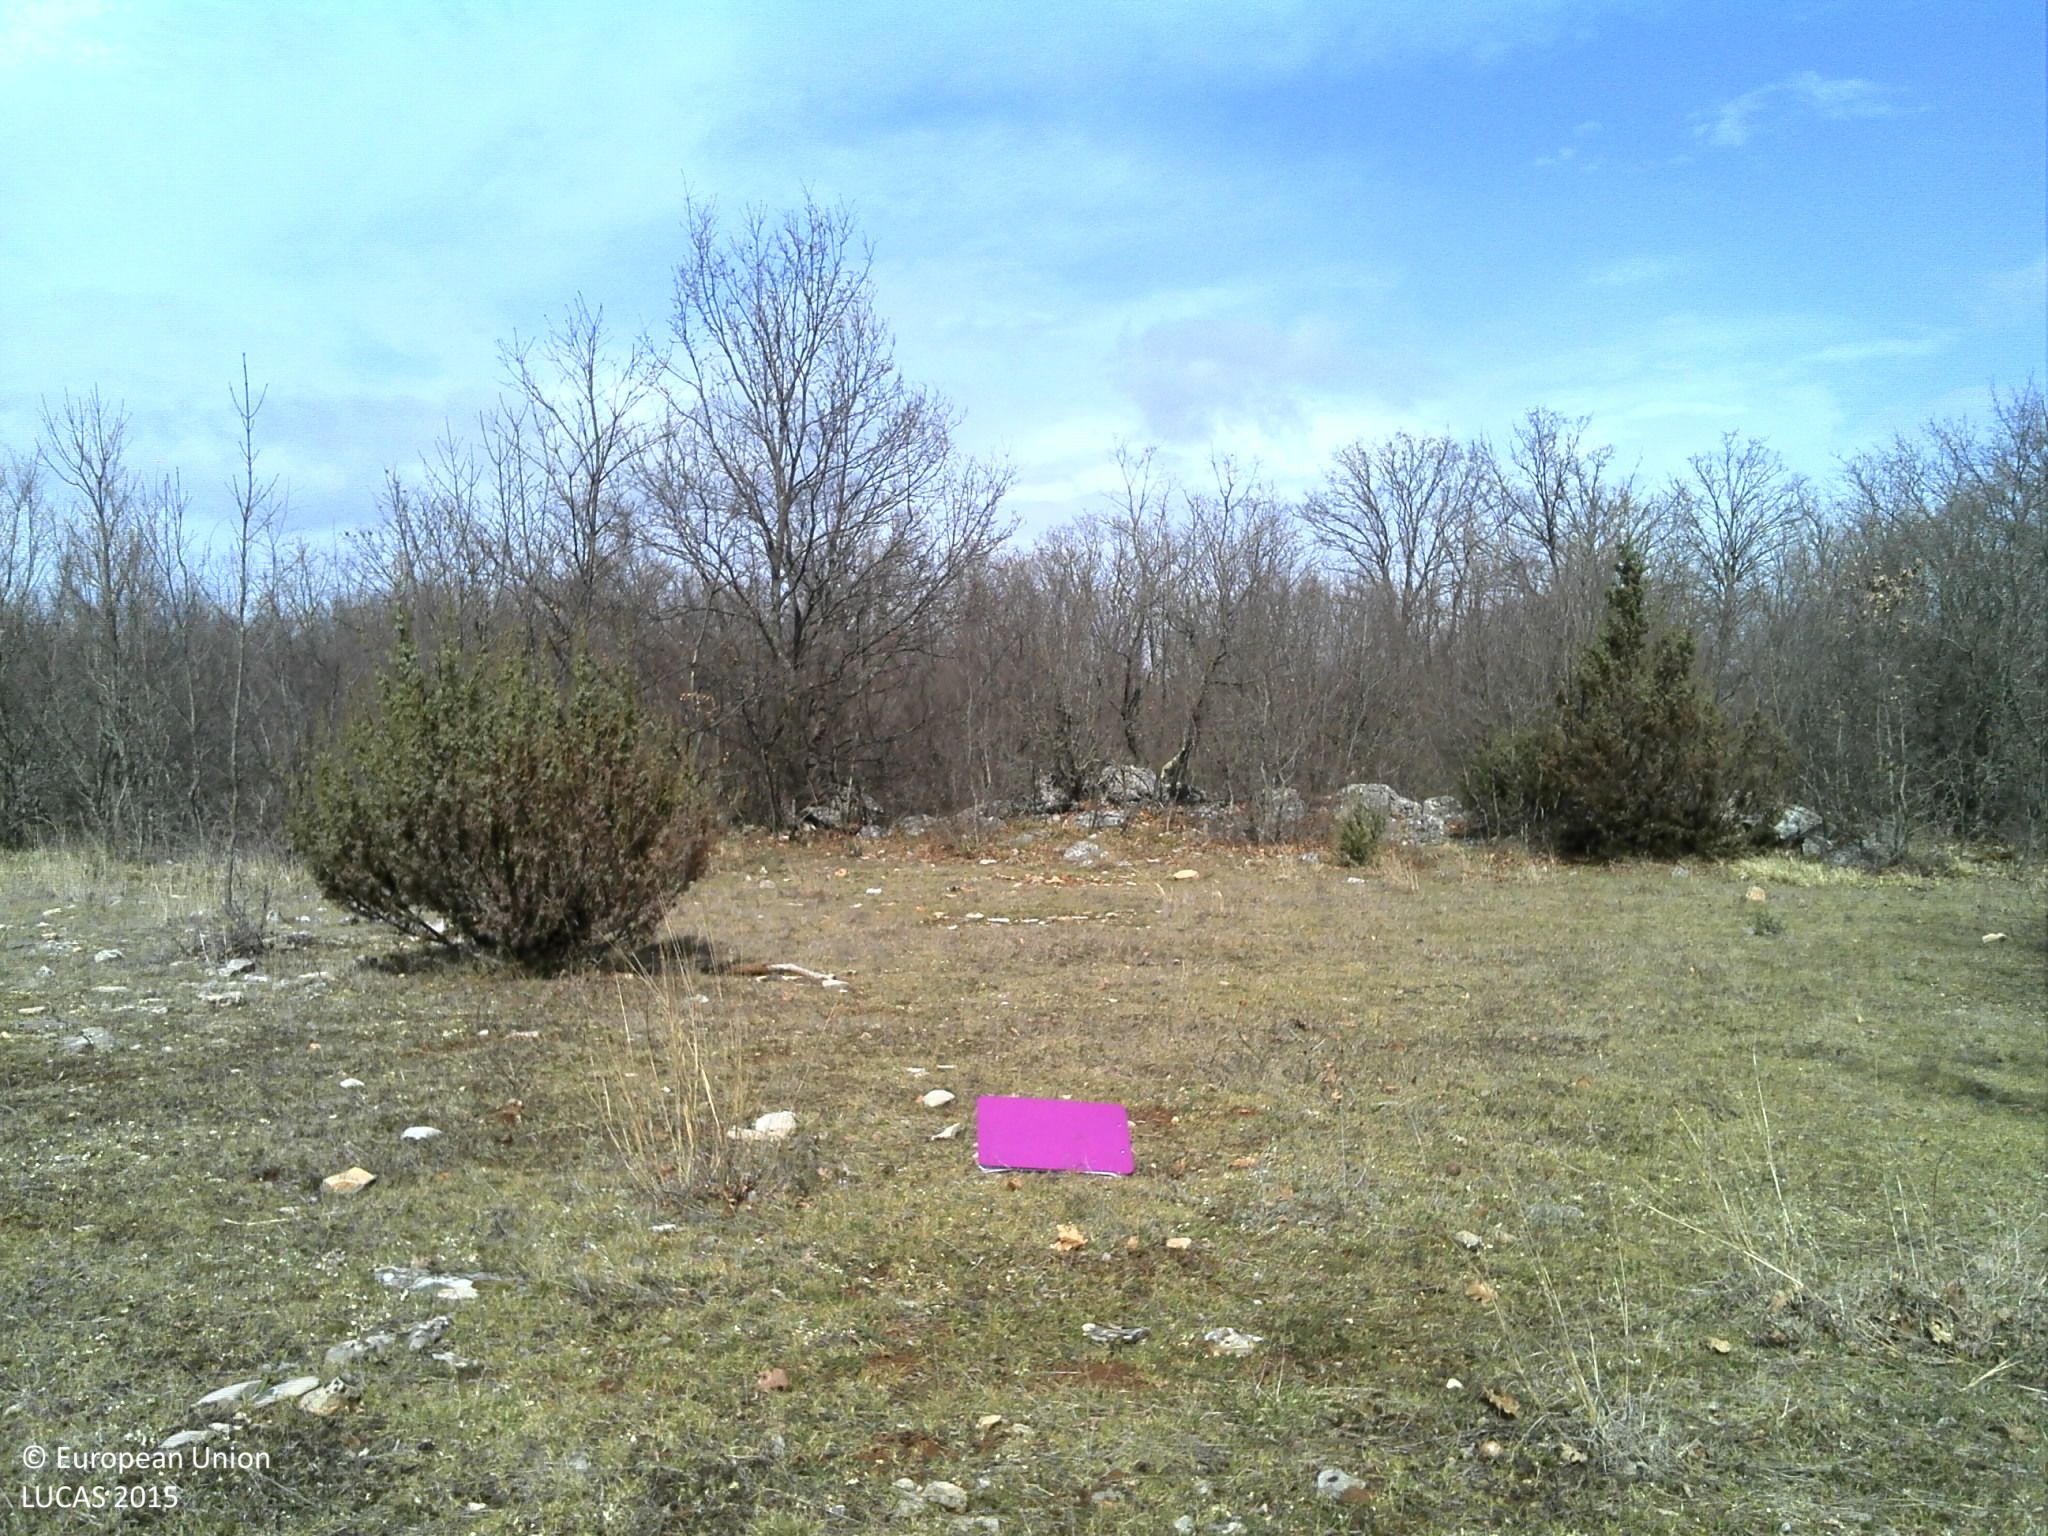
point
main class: Woodland
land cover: Broadleaved woodland
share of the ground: 25 - 50 %
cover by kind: broadleaved forest trees 40 %, herbaceous plants 35 %, lichens and mosses 10 %, unconsolidated bare surface 10 %, consolidated bare surface 5 %
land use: Agriculture (excluding fallow land and kitchen gardens)
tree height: > 5 m
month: March
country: HR
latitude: 44.0397
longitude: 15.8698
